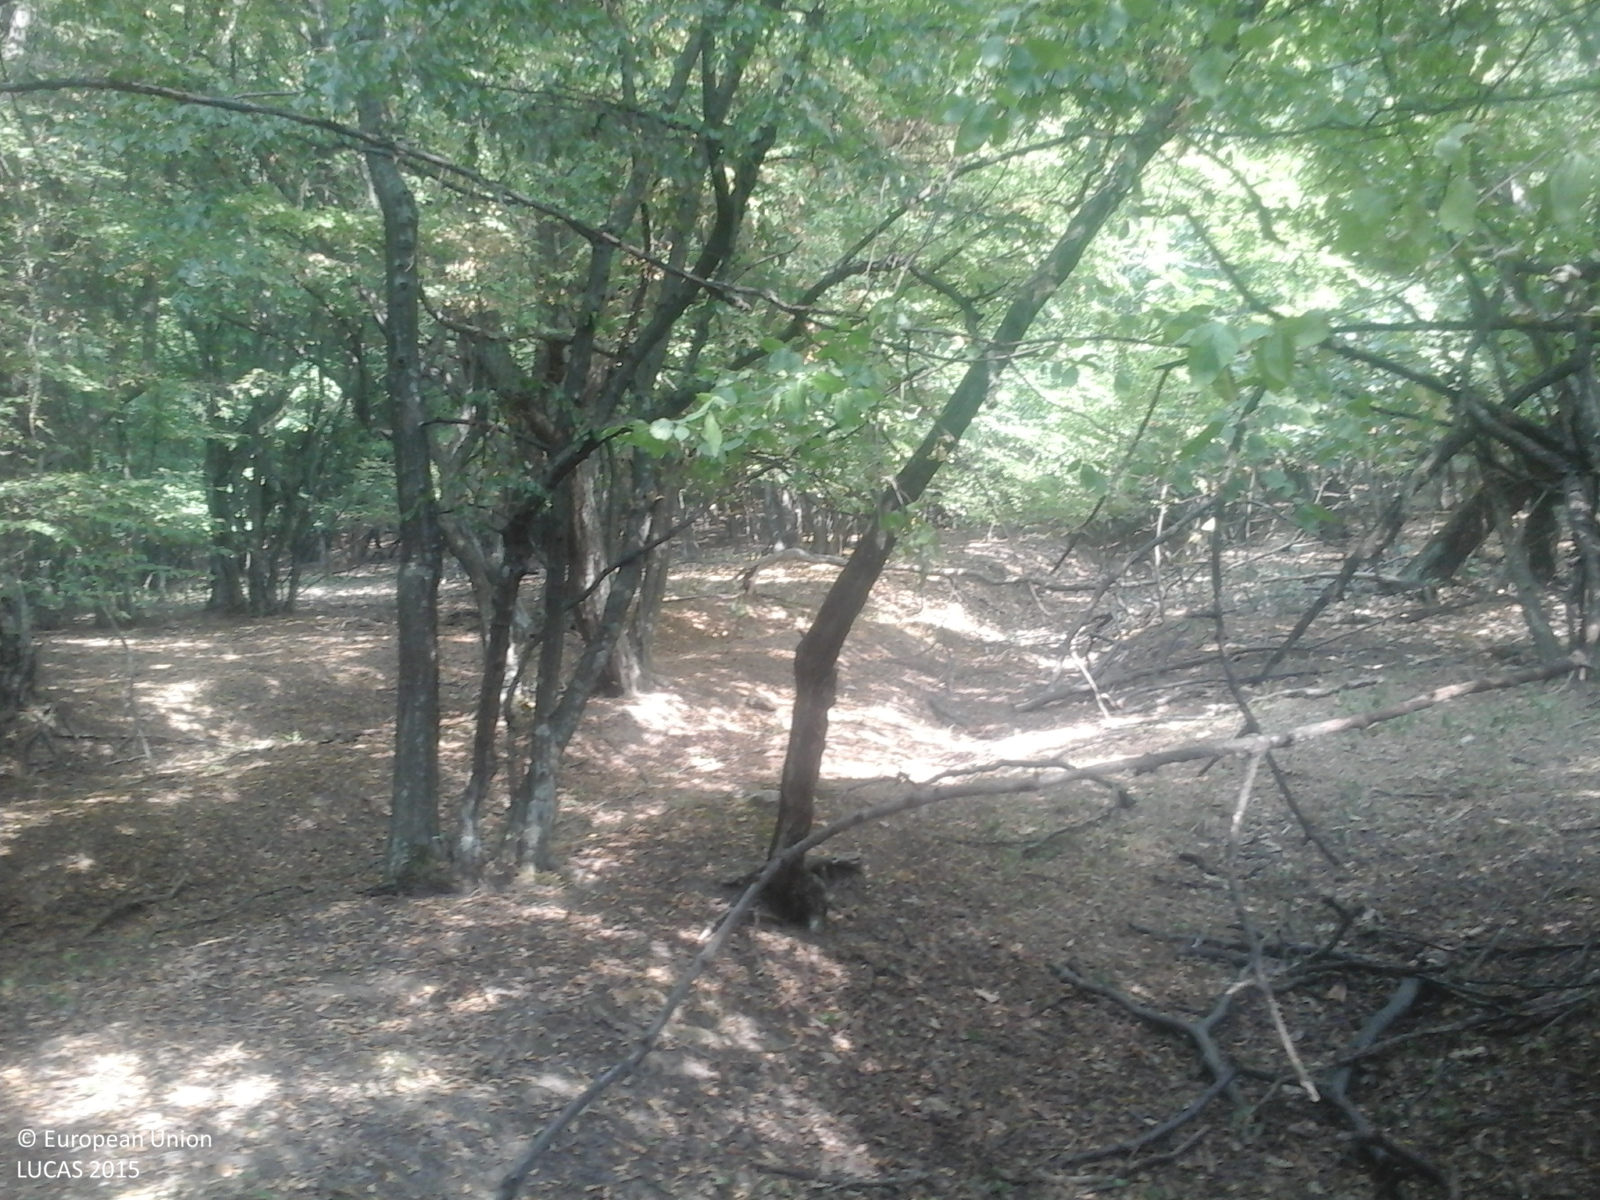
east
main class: Woodland
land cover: Broadleaved woodland
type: mesophytic deciduous forest
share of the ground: > 75 %
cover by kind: broadleaved forest trees 100 %
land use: Forestry
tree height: > 5 m
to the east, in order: Broadleaved woodland
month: July
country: RO
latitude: 45.2517
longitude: 28.3076
